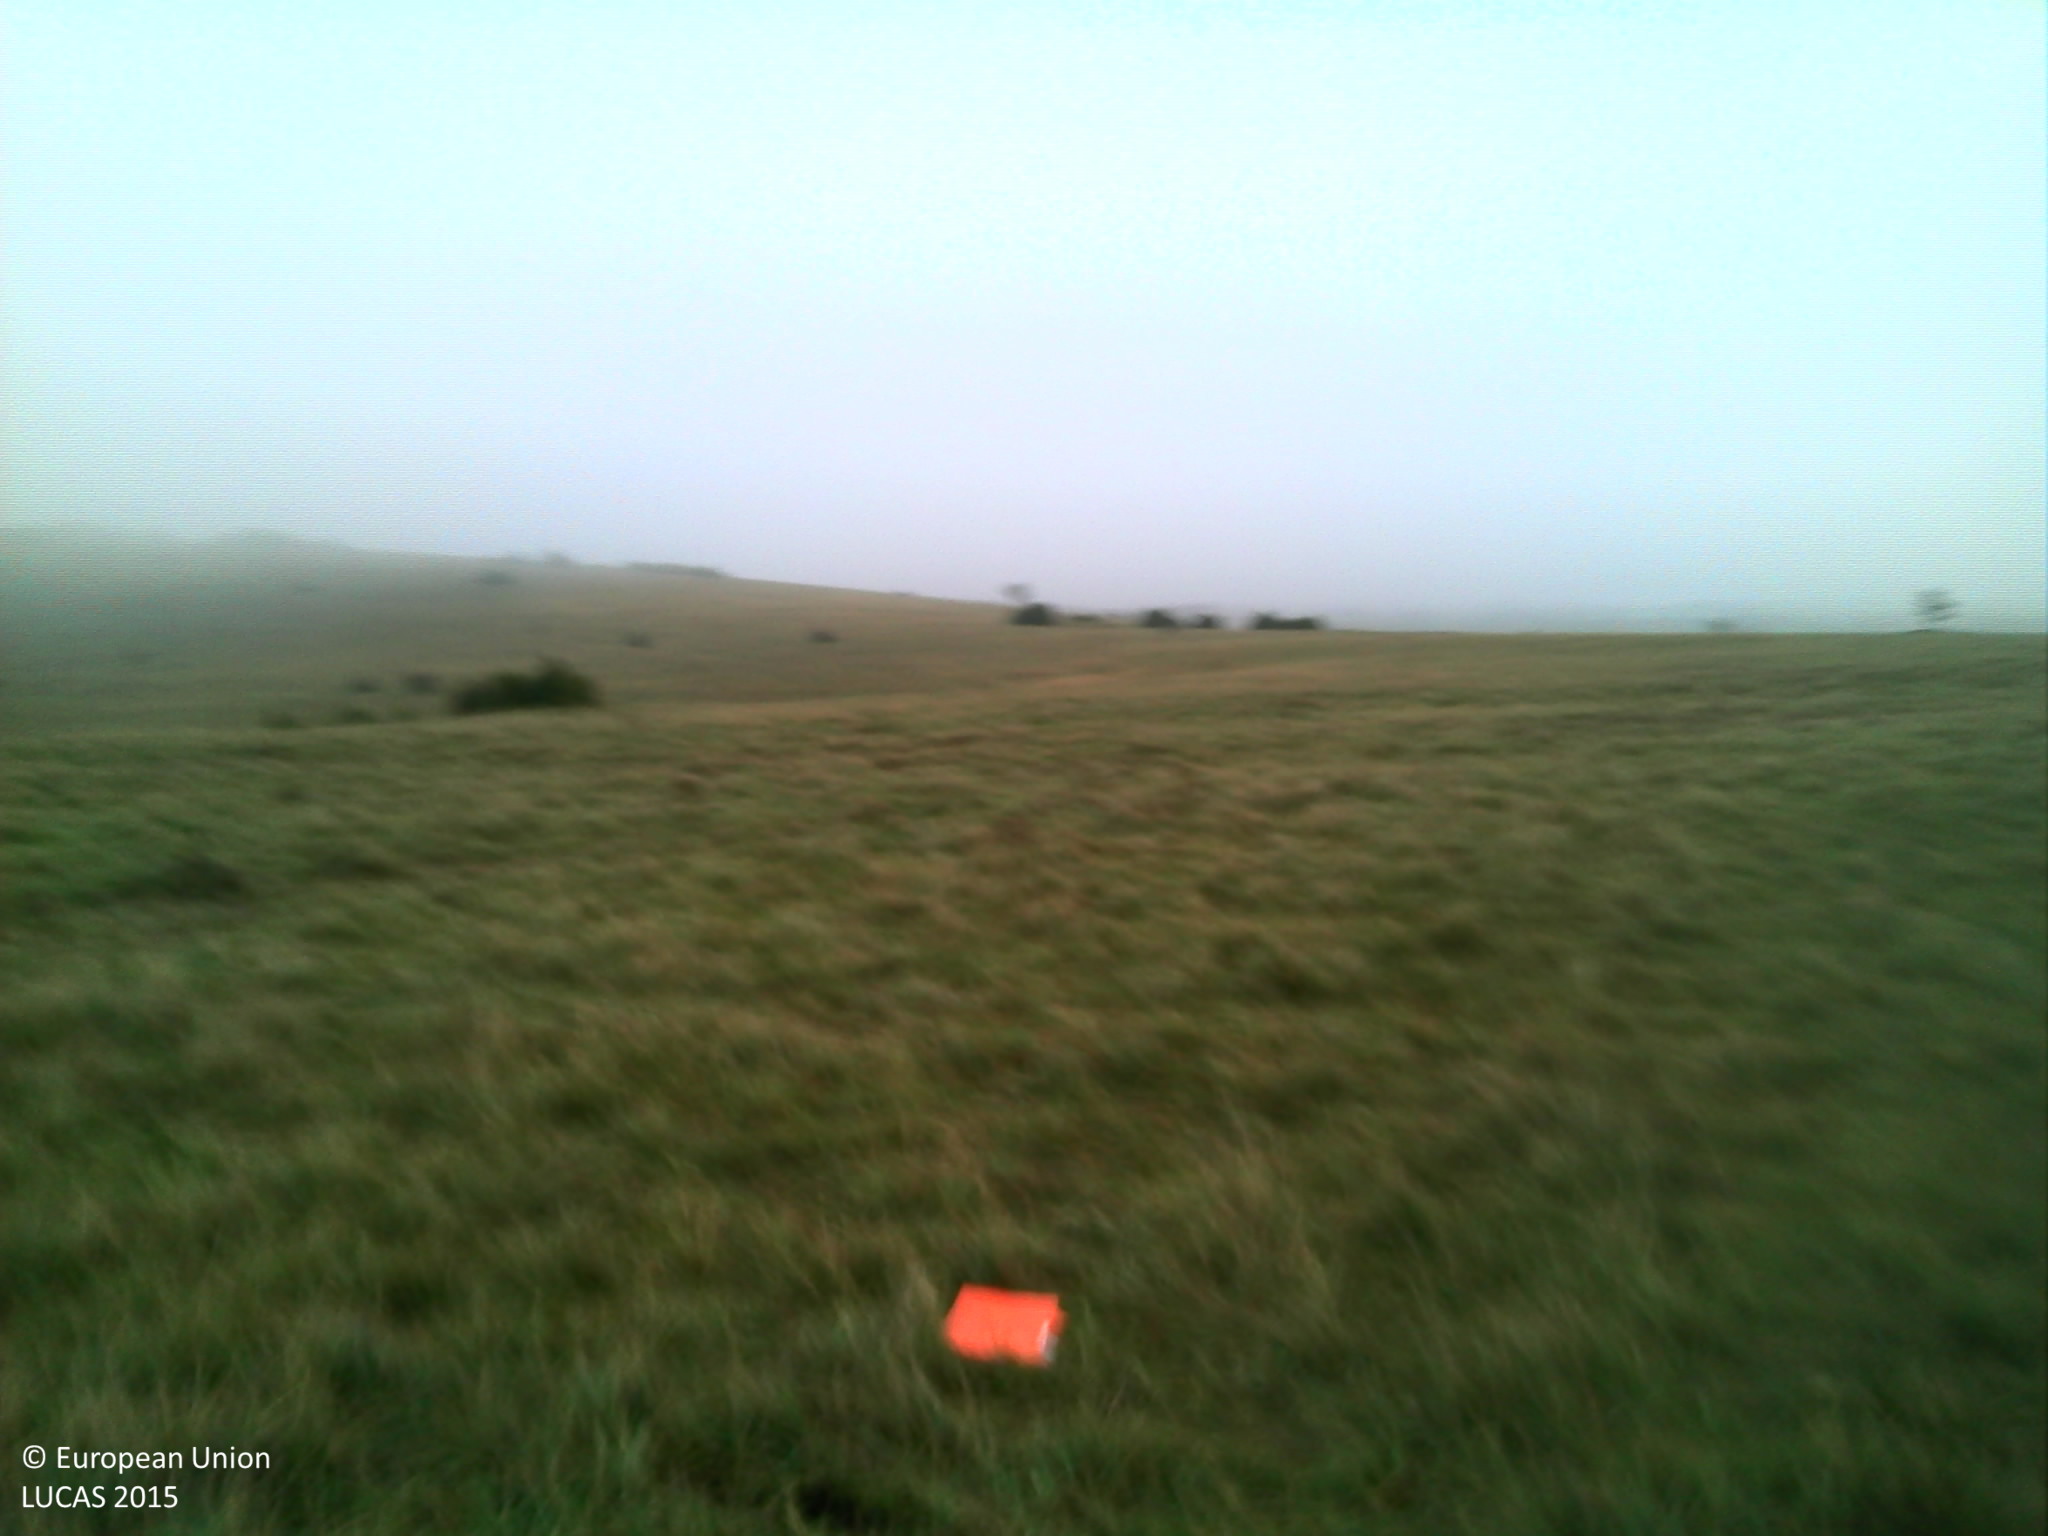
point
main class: Grassland
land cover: Grassland without tree/shrub cover
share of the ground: > 75 %
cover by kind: herbaceous plants 100 %
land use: Agriculture (excluding fallow land and kitchen gardens)
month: November
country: FR
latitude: 44.0290
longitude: 3.0815
